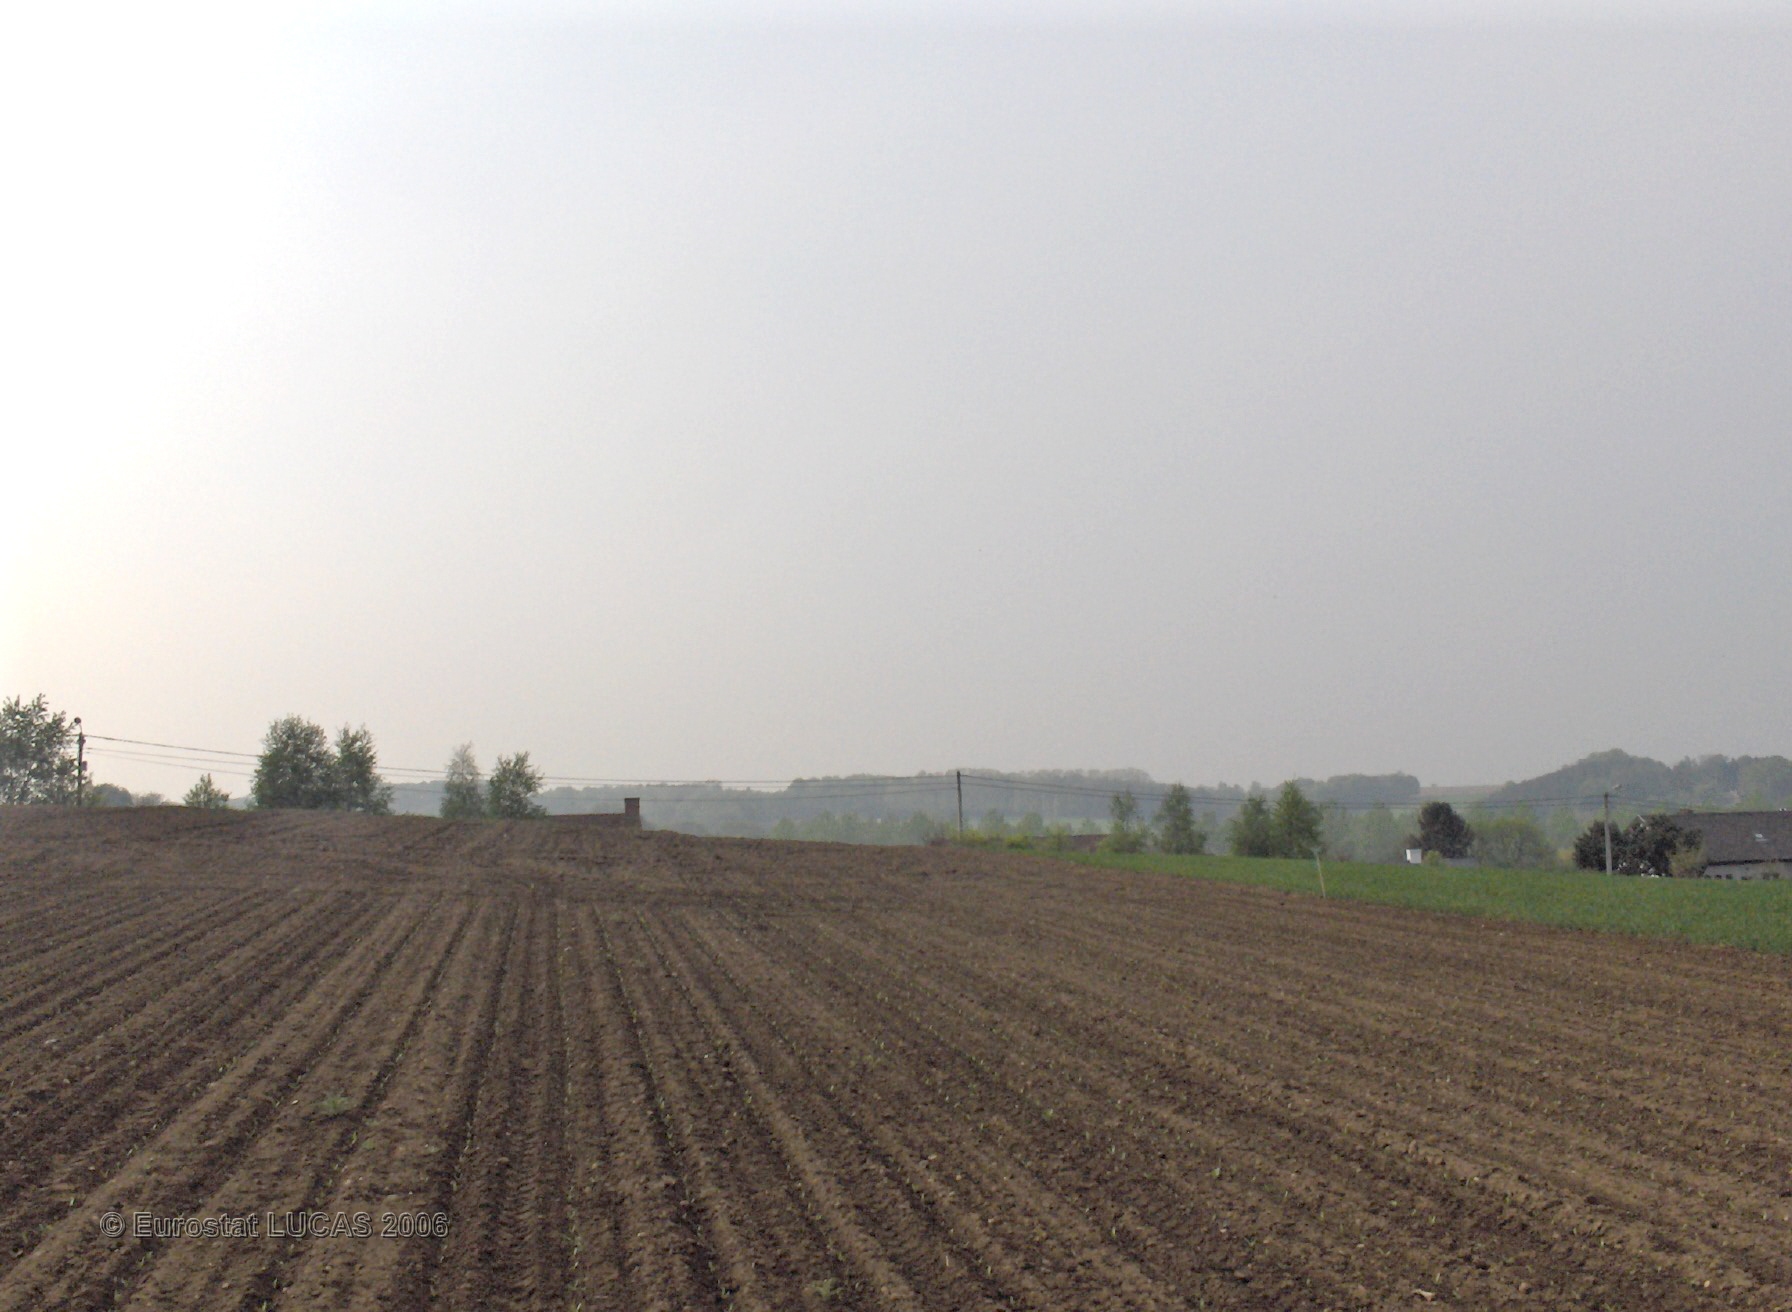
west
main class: Cropland
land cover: Sugar beet
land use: Agriculture (excluding fallow land and kitchen gardens)
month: May
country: BE
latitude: 50.6626
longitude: 4.4642
